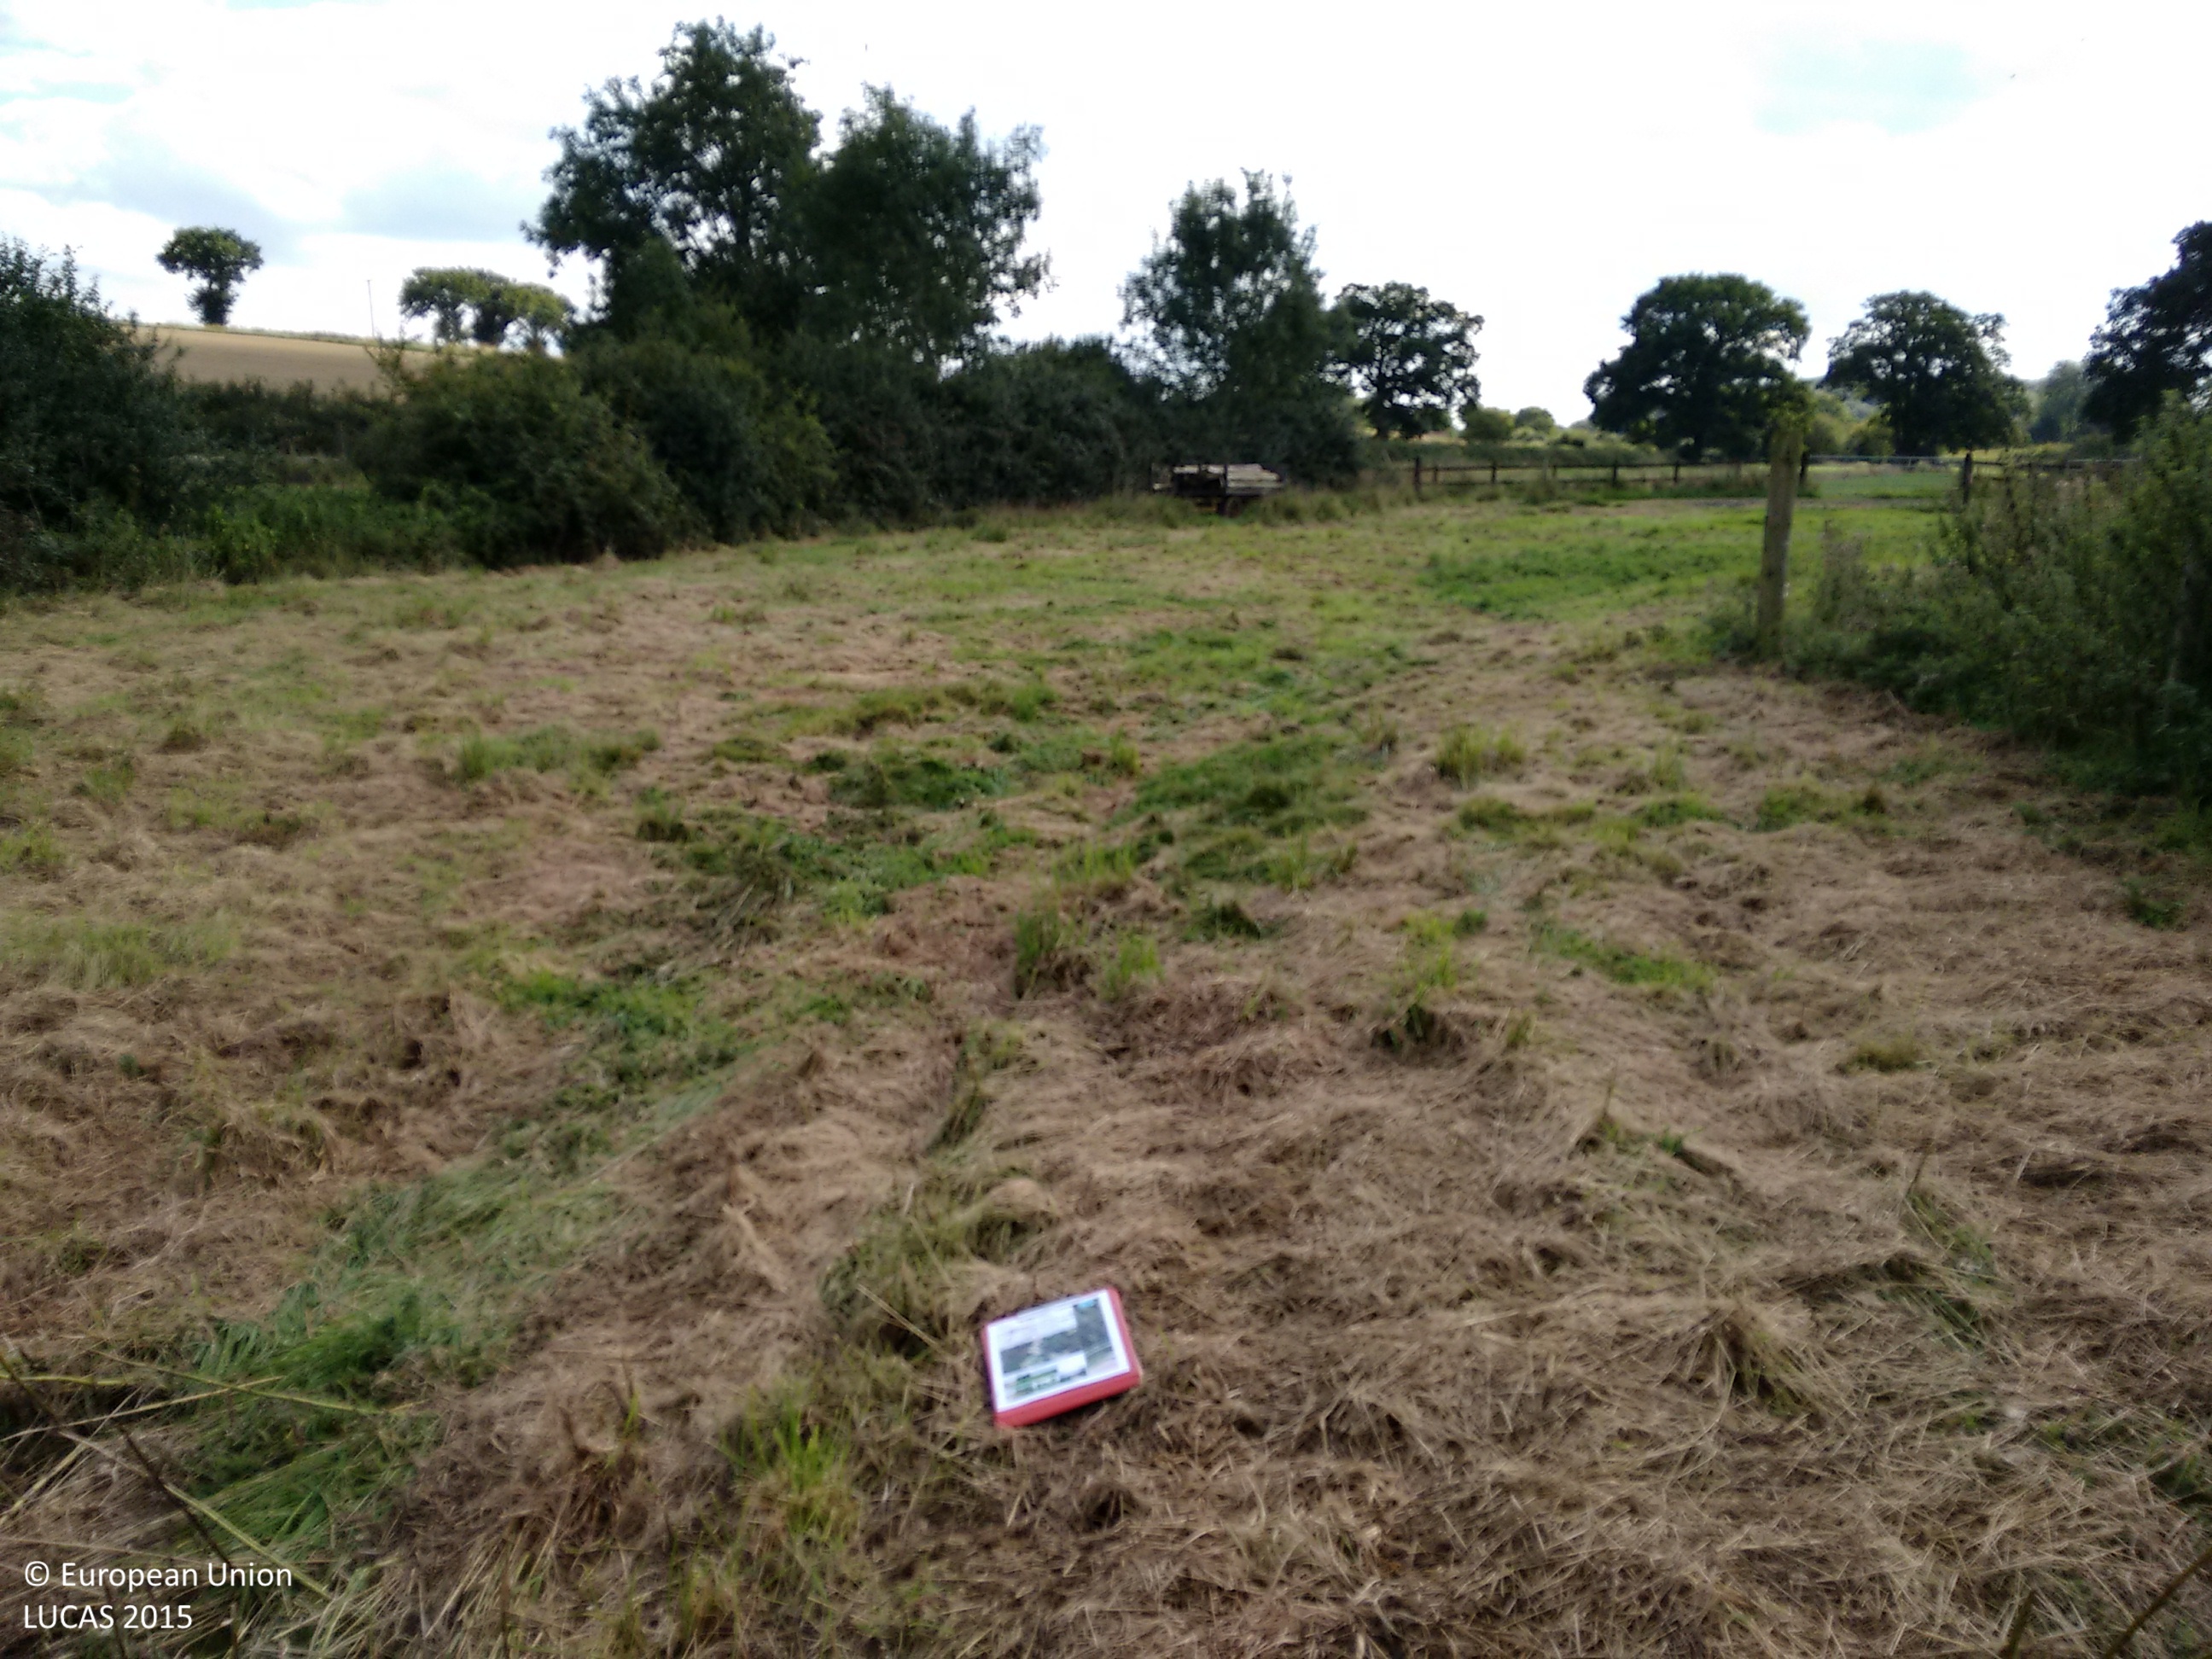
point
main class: Grassland
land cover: Grassland without tree/shrub cover
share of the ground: > 75 %
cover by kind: herbaceous plants 100 %
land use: Agriculture (excluding fallow land and kitchen gardens)
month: September
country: GB
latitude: 52.5298
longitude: 1.3268
